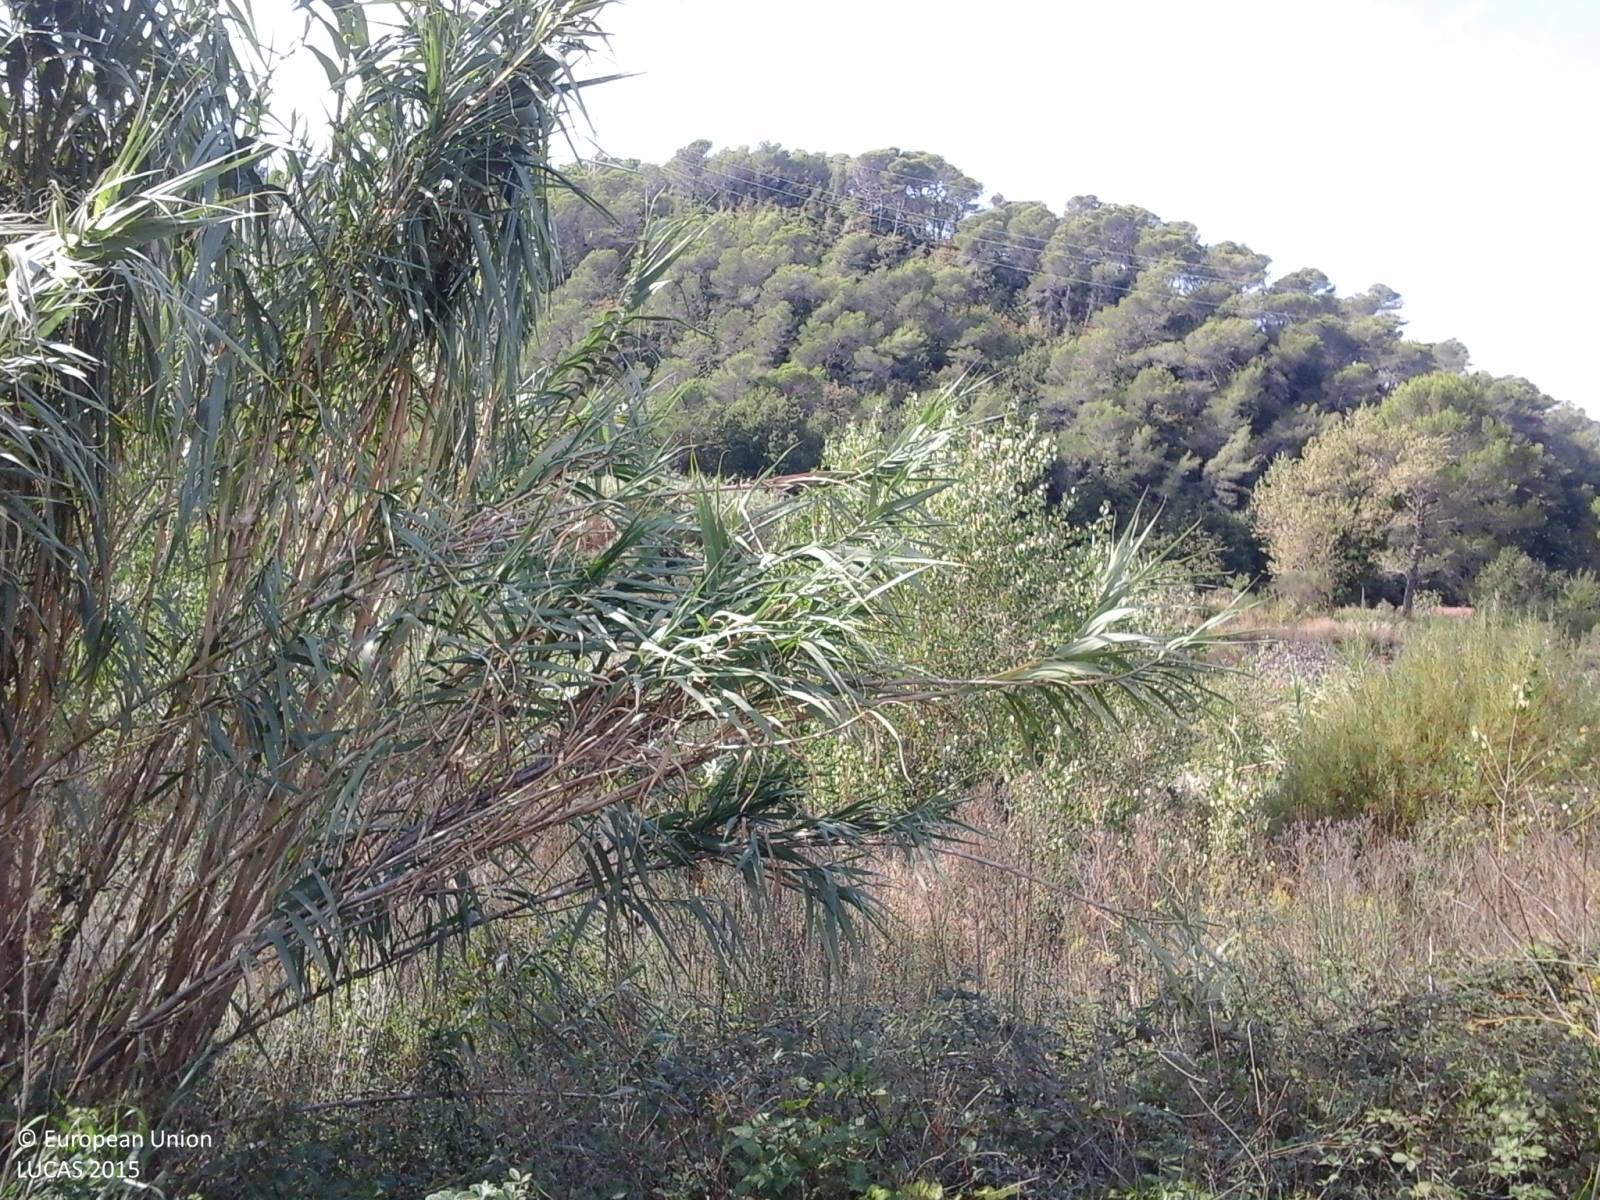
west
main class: Shrubland
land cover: Shrubland with sparse tree cover
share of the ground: > 75 %
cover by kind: shrubs 60 %, herbaceous plants 30 %, broadleaved forest trees 5 %, consolidated bare surface 5 %
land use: Semi-natural and natural areas not in use
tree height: < 5 m
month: October
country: IT
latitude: 43.9907
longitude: 8.1217
